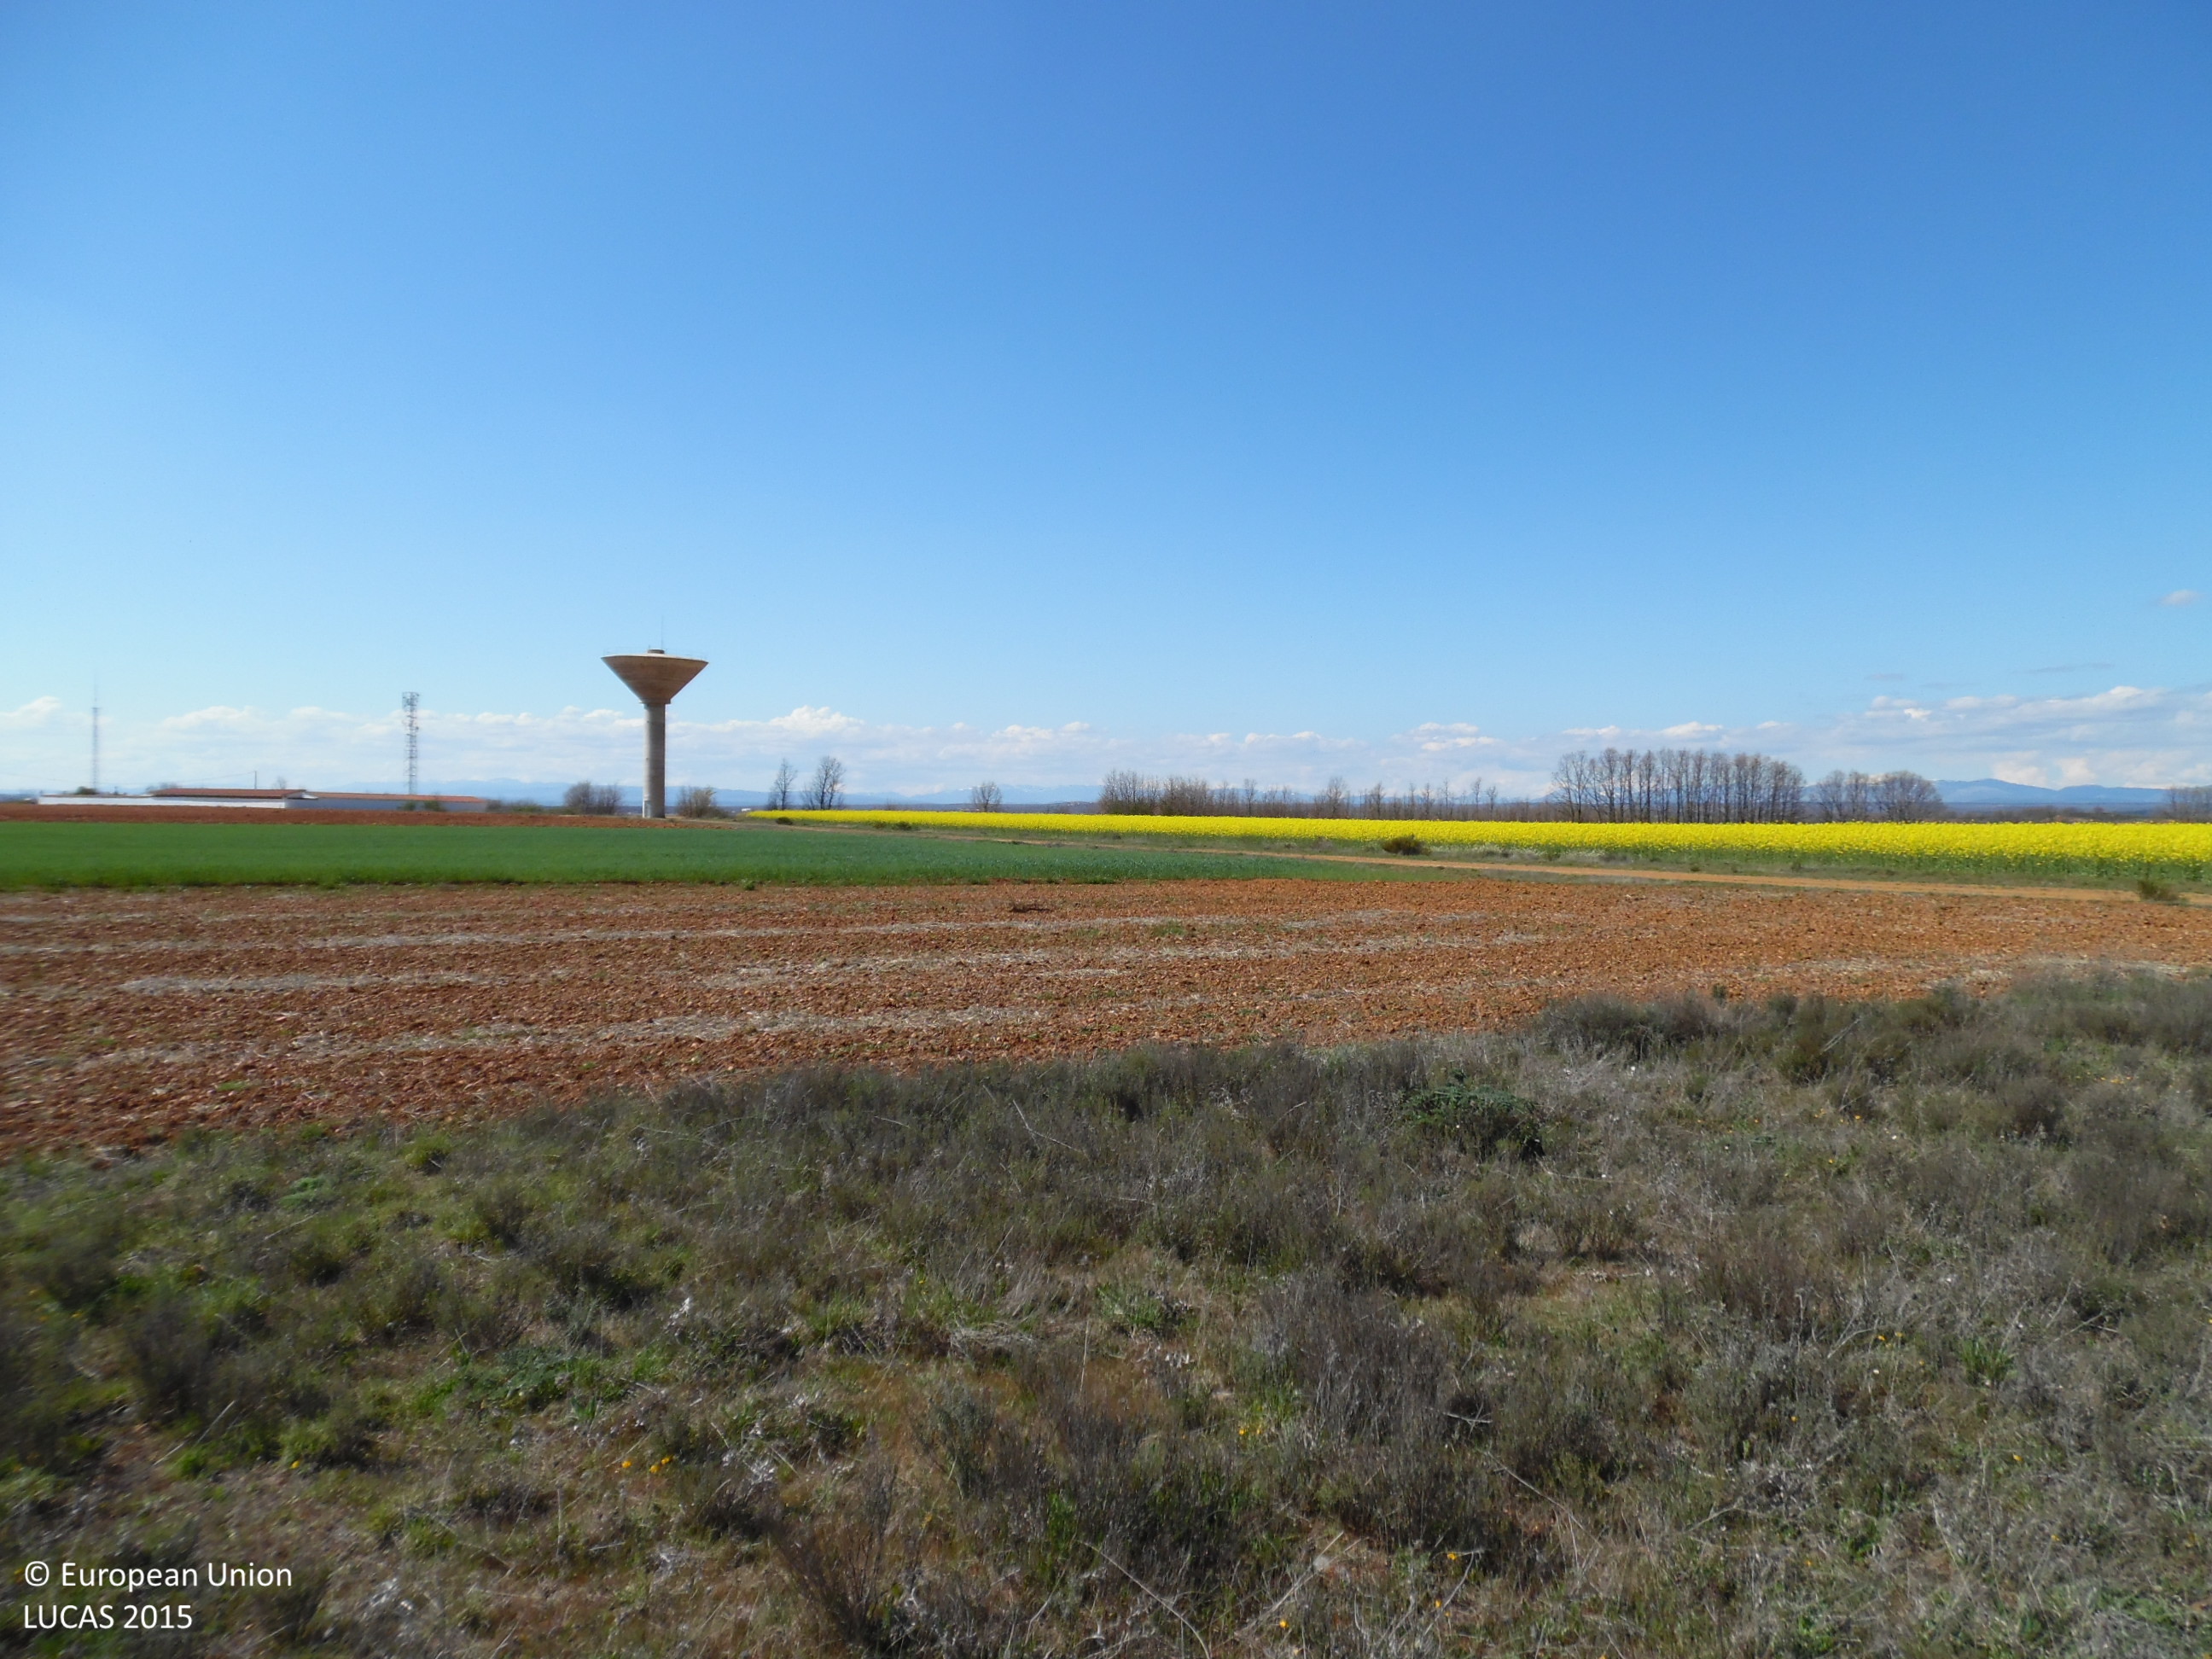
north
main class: Shrubland
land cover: Shrubland without tree cover
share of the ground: 50 - 75 %
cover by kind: shrubs 60 %, herbaceous plants 40 %
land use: Abandoned areas
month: April
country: ES
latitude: 42.5236
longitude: -5.6925
